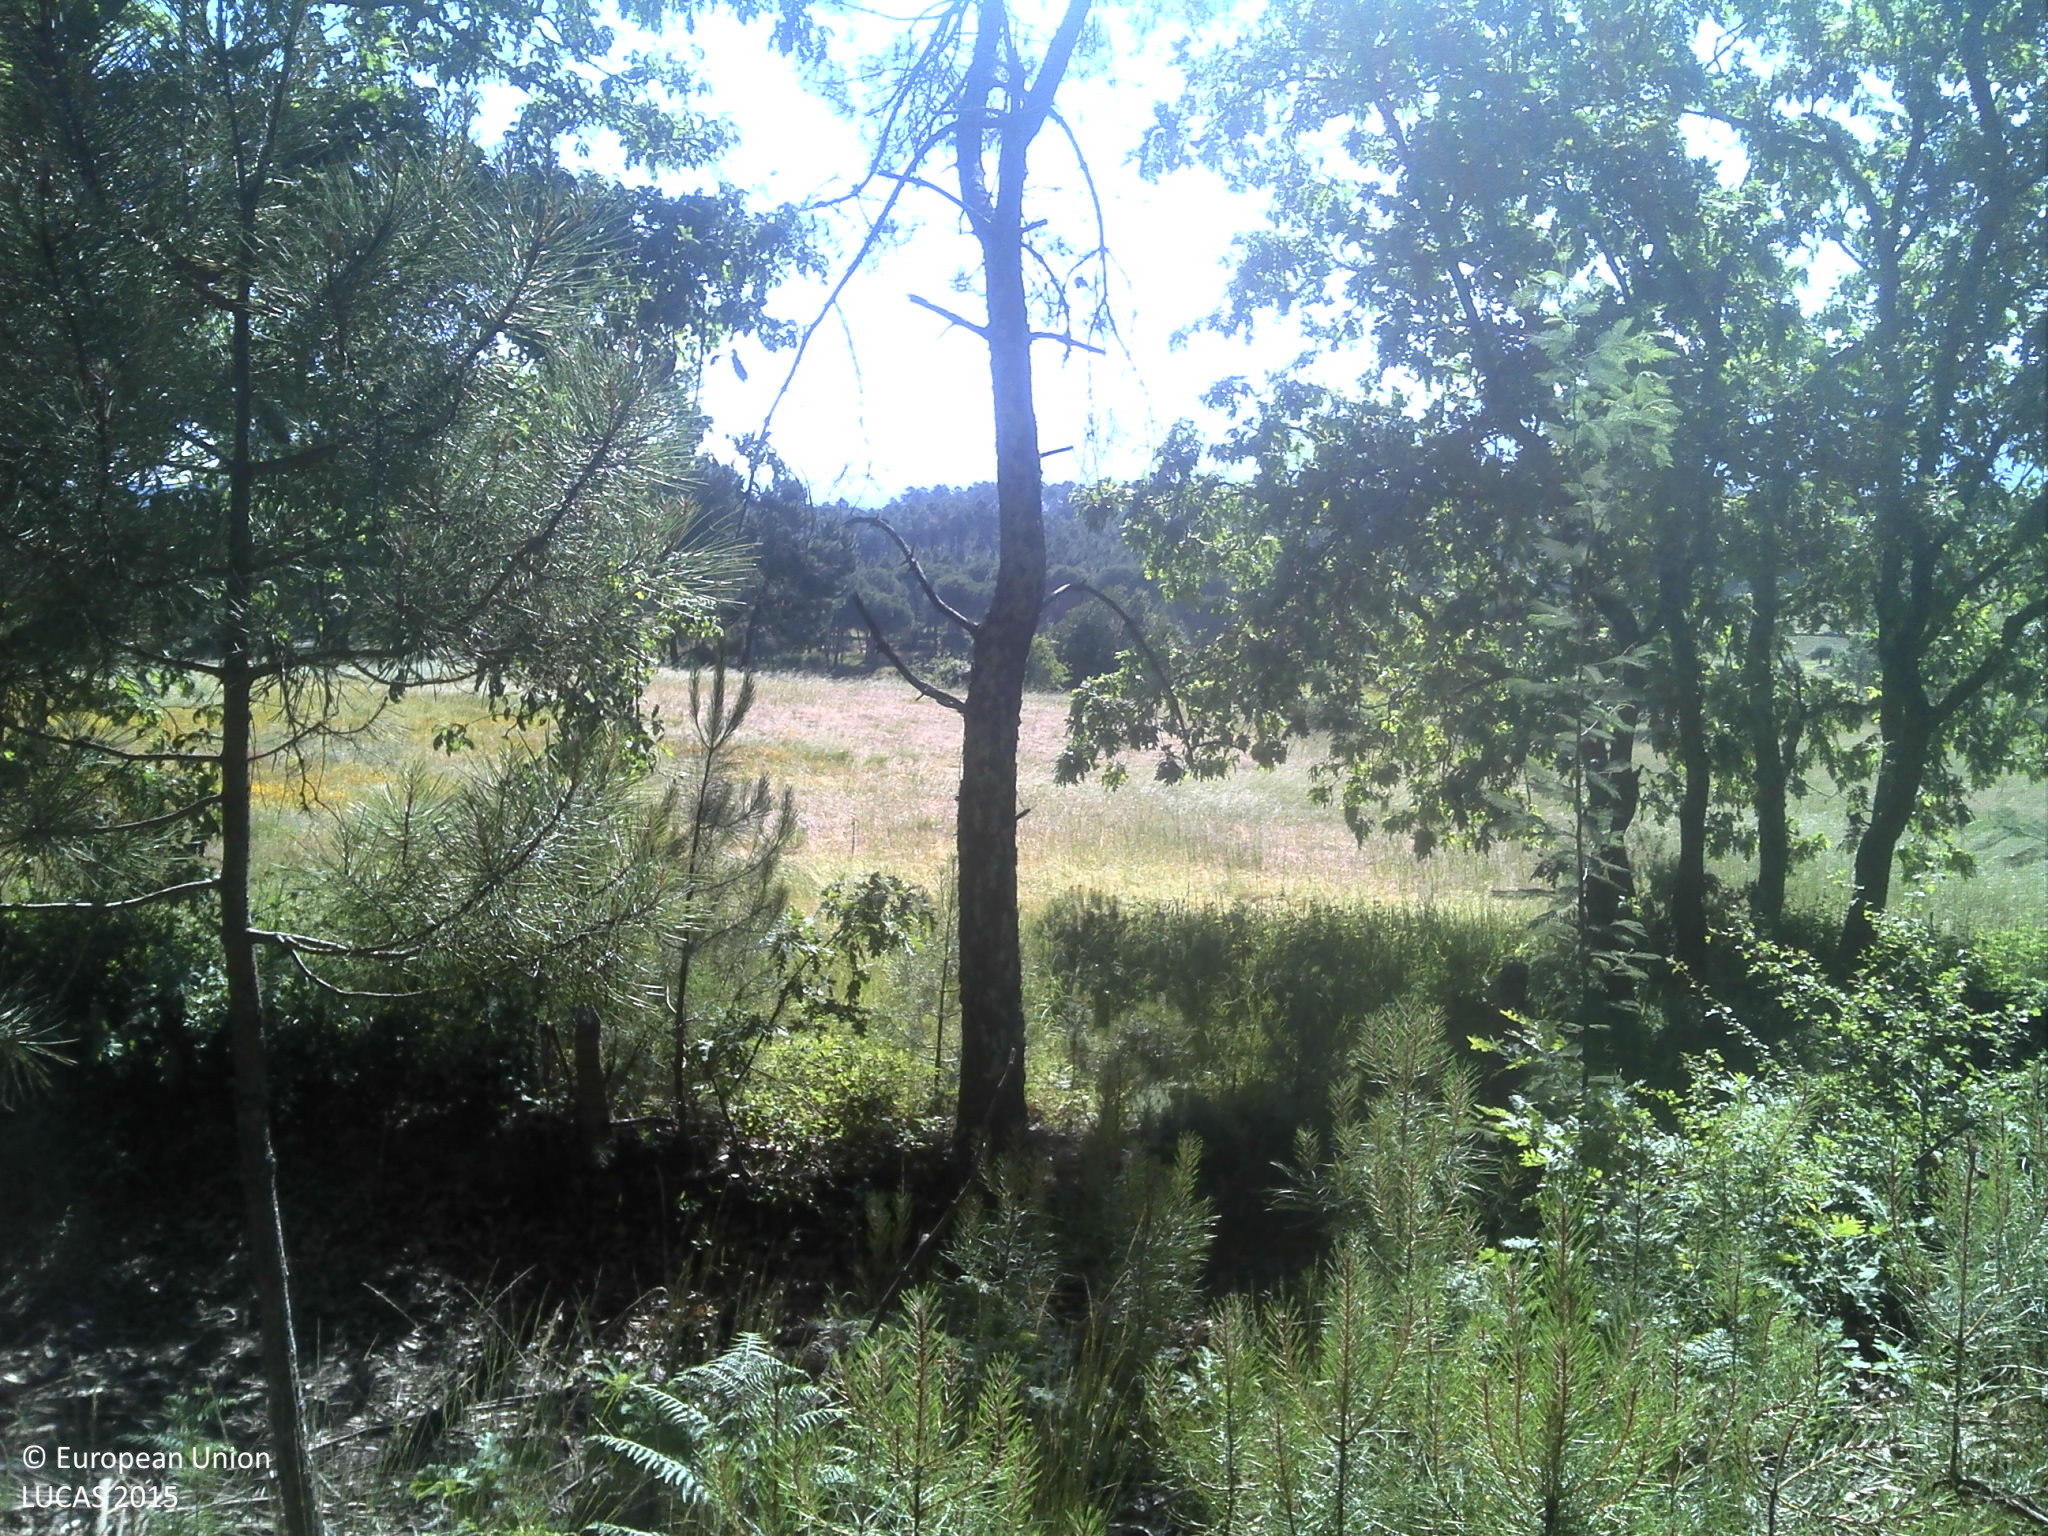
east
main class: Woodland
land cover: Pine dominated coniferous woodland
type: coniferous forest of the mediterranean region
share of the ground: 50 - 75 %
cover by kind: coniferous forest trees 70 %, shrubs 20 %, unconsolidated bare surface 10 %
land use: Forestry
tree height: > 5 m
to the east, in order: Pine dominated coniferous woodland; Tracks; Fences; Broadleaved woodland; Grassland without tree/shrub cover; Fences; Grassland without tree/shrub cover; Fences; Grassland without tree/shrub cover; Fences; Grassland without tree/shrub cover
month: May
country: PT
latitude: 40.4628
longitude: -7.7476
